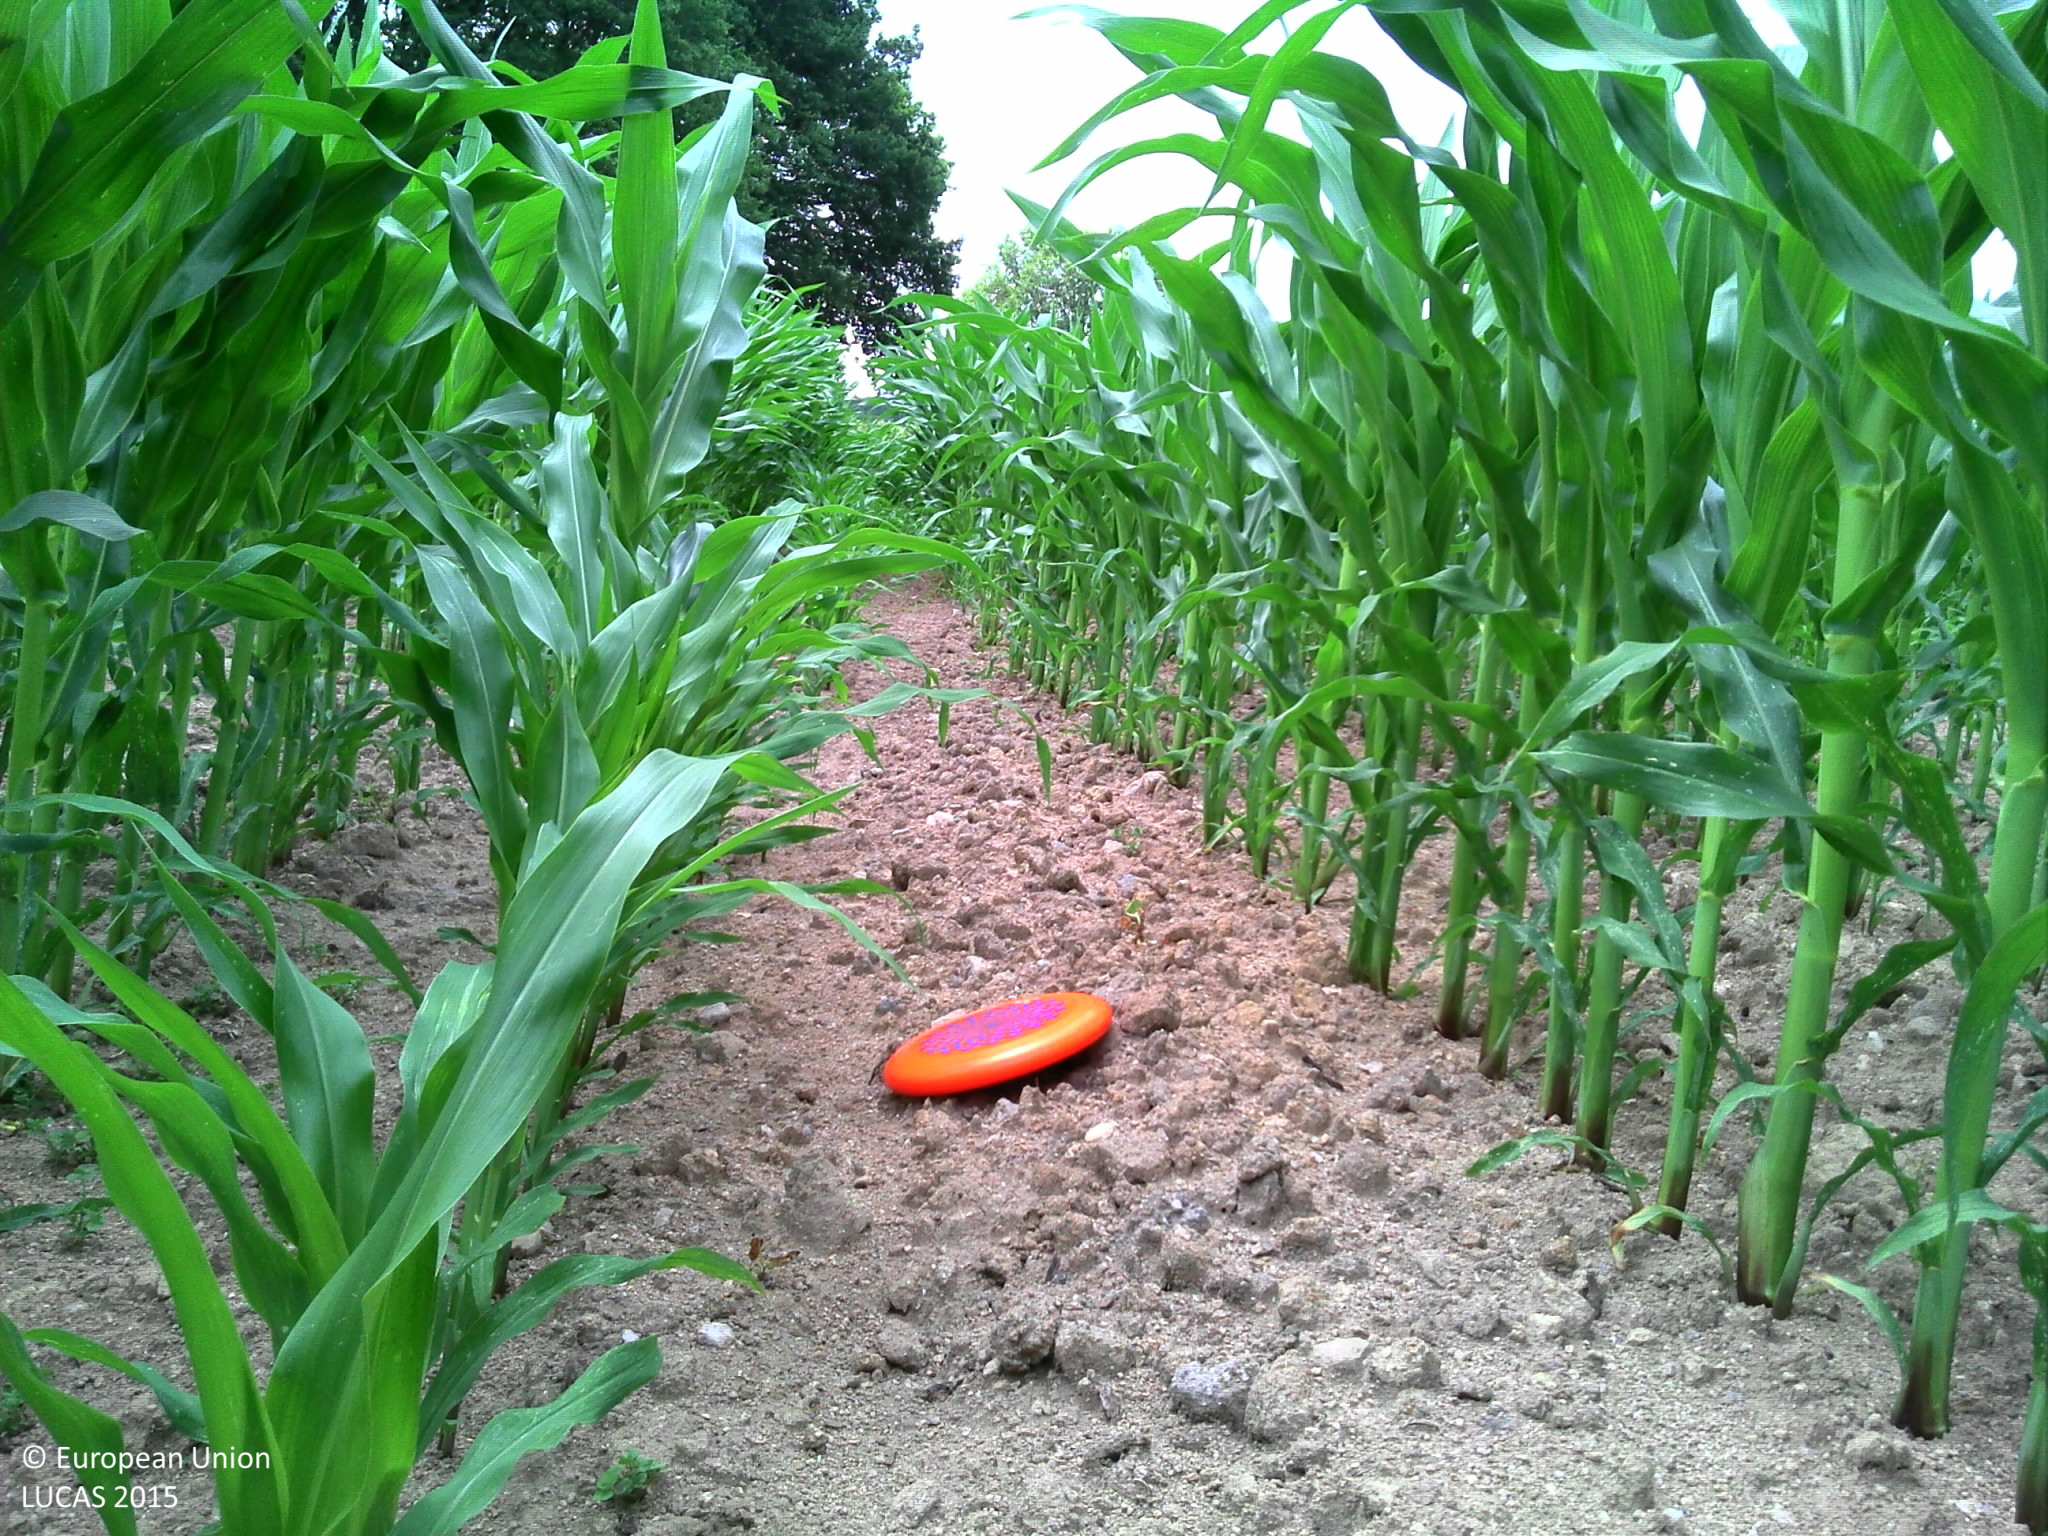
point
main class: Cropland
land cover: Maize
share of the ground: > 75 %
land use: Agriculture (excluding fallow land and kitchen gardens)
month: July
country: FR
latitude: 45.7627
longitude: 1.7781
